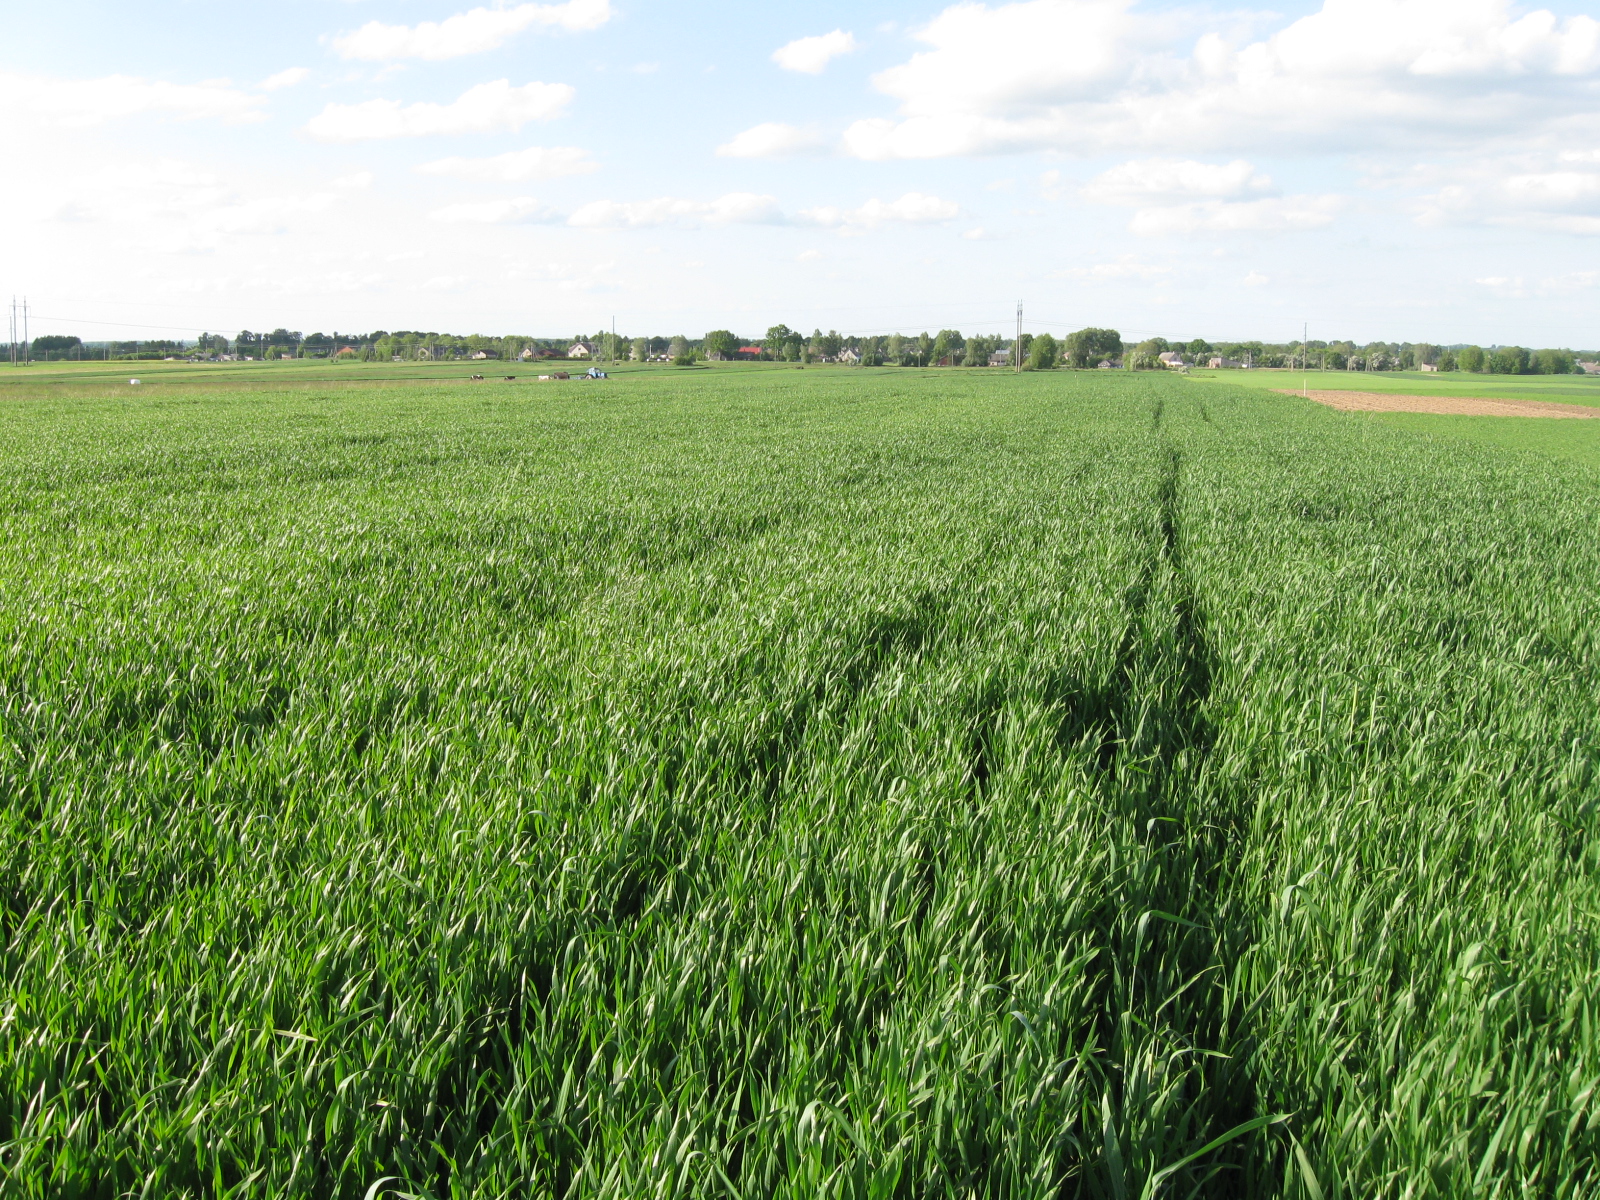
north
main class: Cropland
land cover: Common wheat
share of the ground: > 75 %
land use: Agriculture (excluding fallow land and kitchen gardens)
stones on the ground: < 10 %
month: May
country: LT
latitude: 54.6125
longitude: 22.8122
